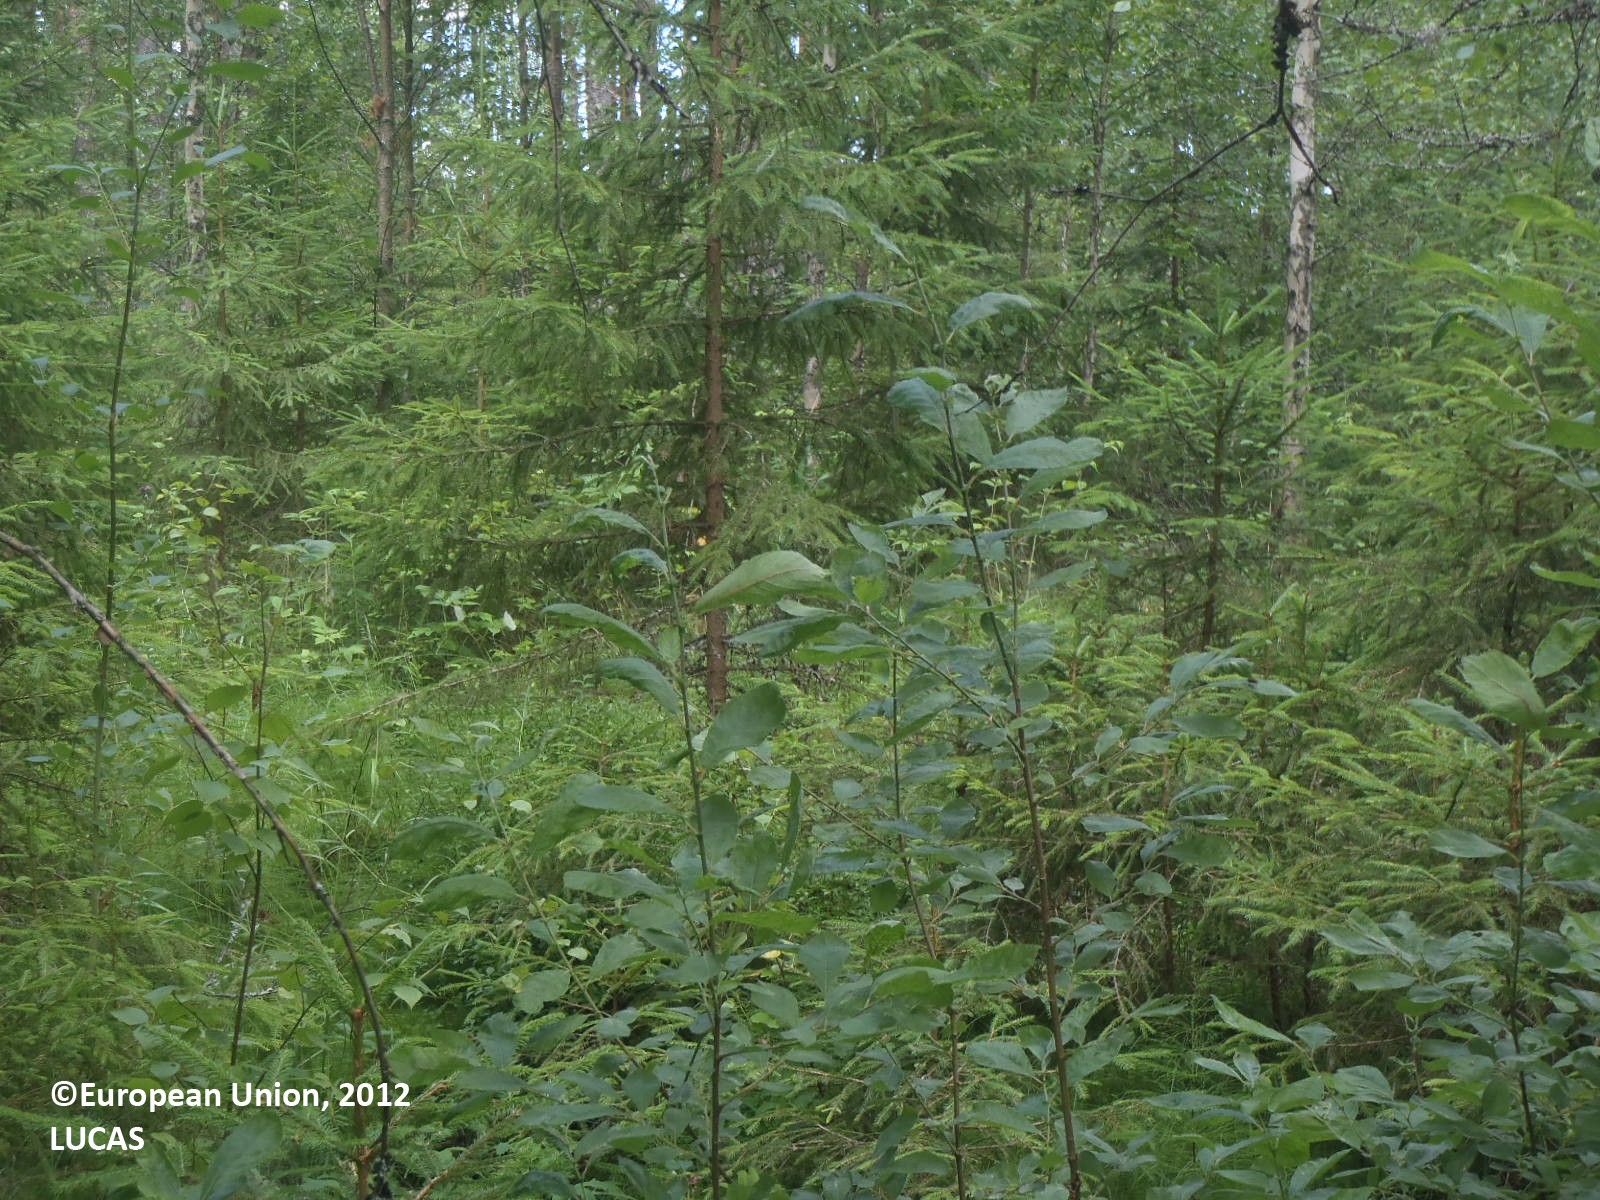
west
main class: Woodland
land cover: Spruce dominated mixed woodland
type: boreal forest
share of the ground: 50 - 75 %
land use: Forestry
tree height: > 5 m
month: July
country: FI
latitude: 60.9760
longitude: 21.8276
